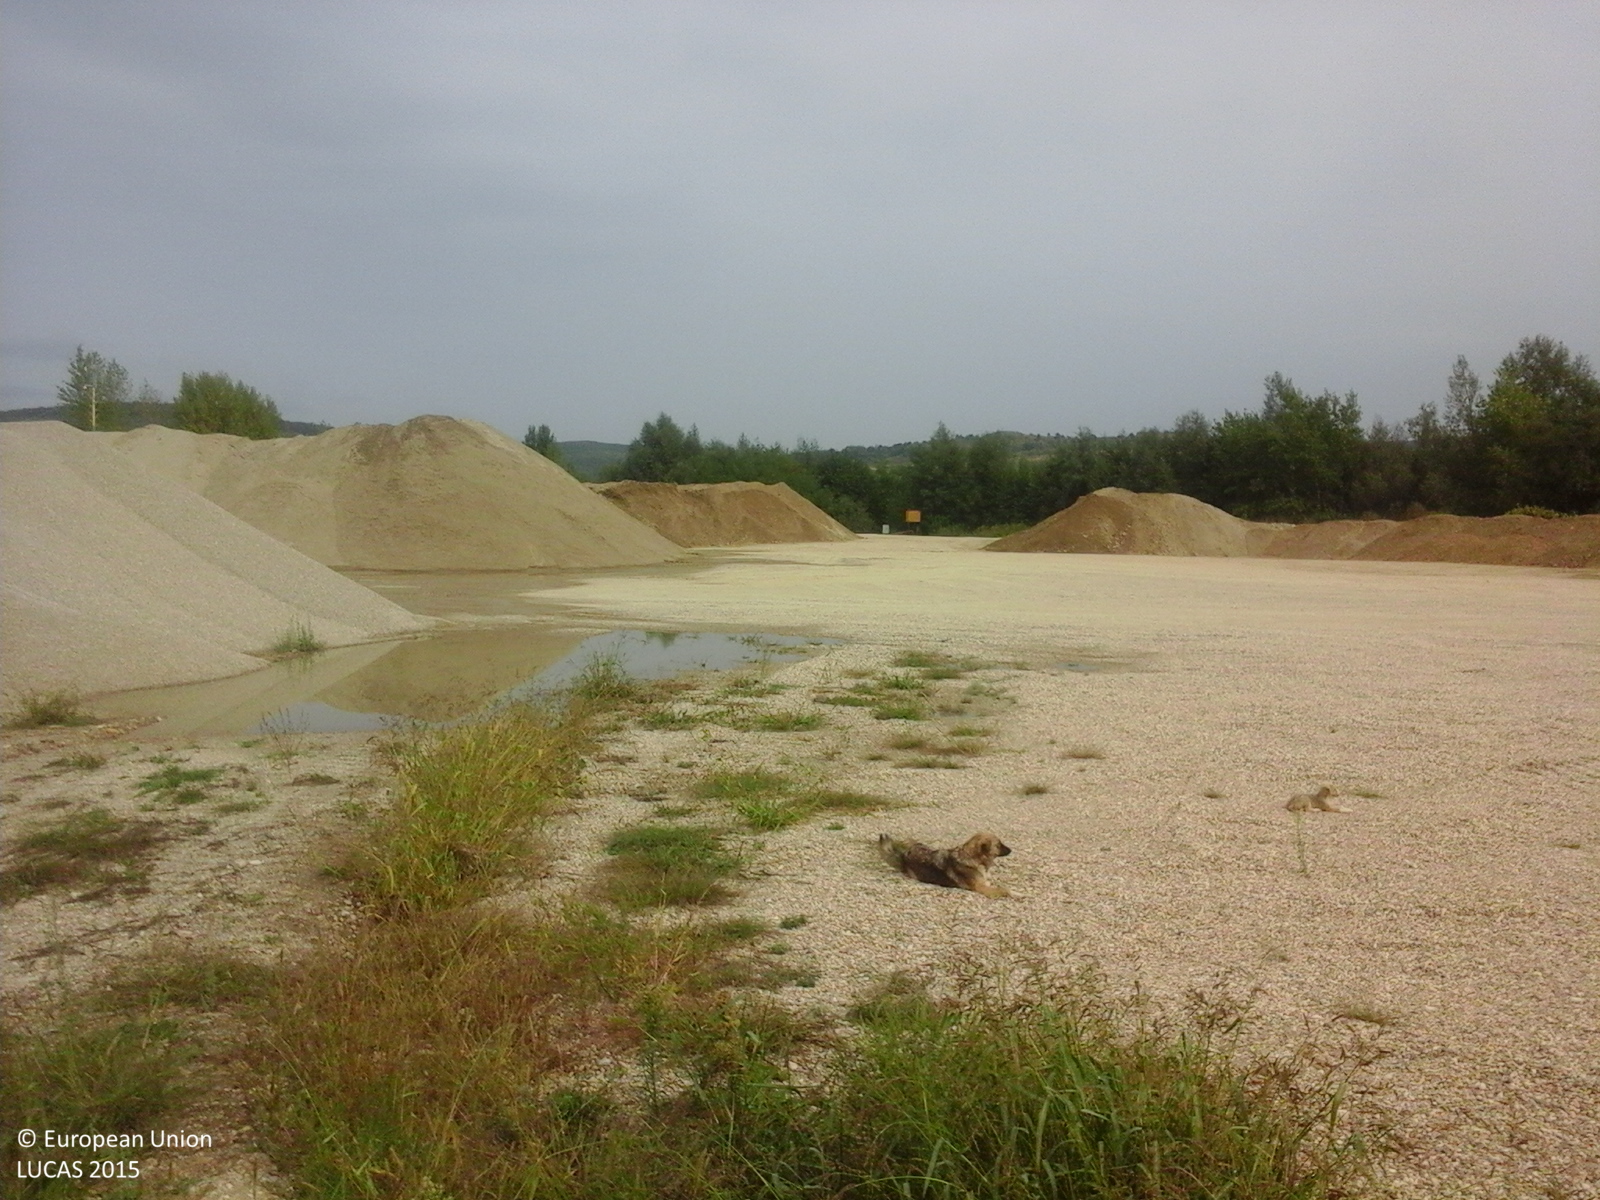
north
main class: Grassland
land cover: Spontaneously vegetated surfaces
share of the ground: 50 - 75 %
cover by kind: herbaceous plants 75 %, unconsolidated bare surface 25 %
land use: Mining and quarrying
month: September
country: RO
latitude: 45.6562
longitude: 21.9870
